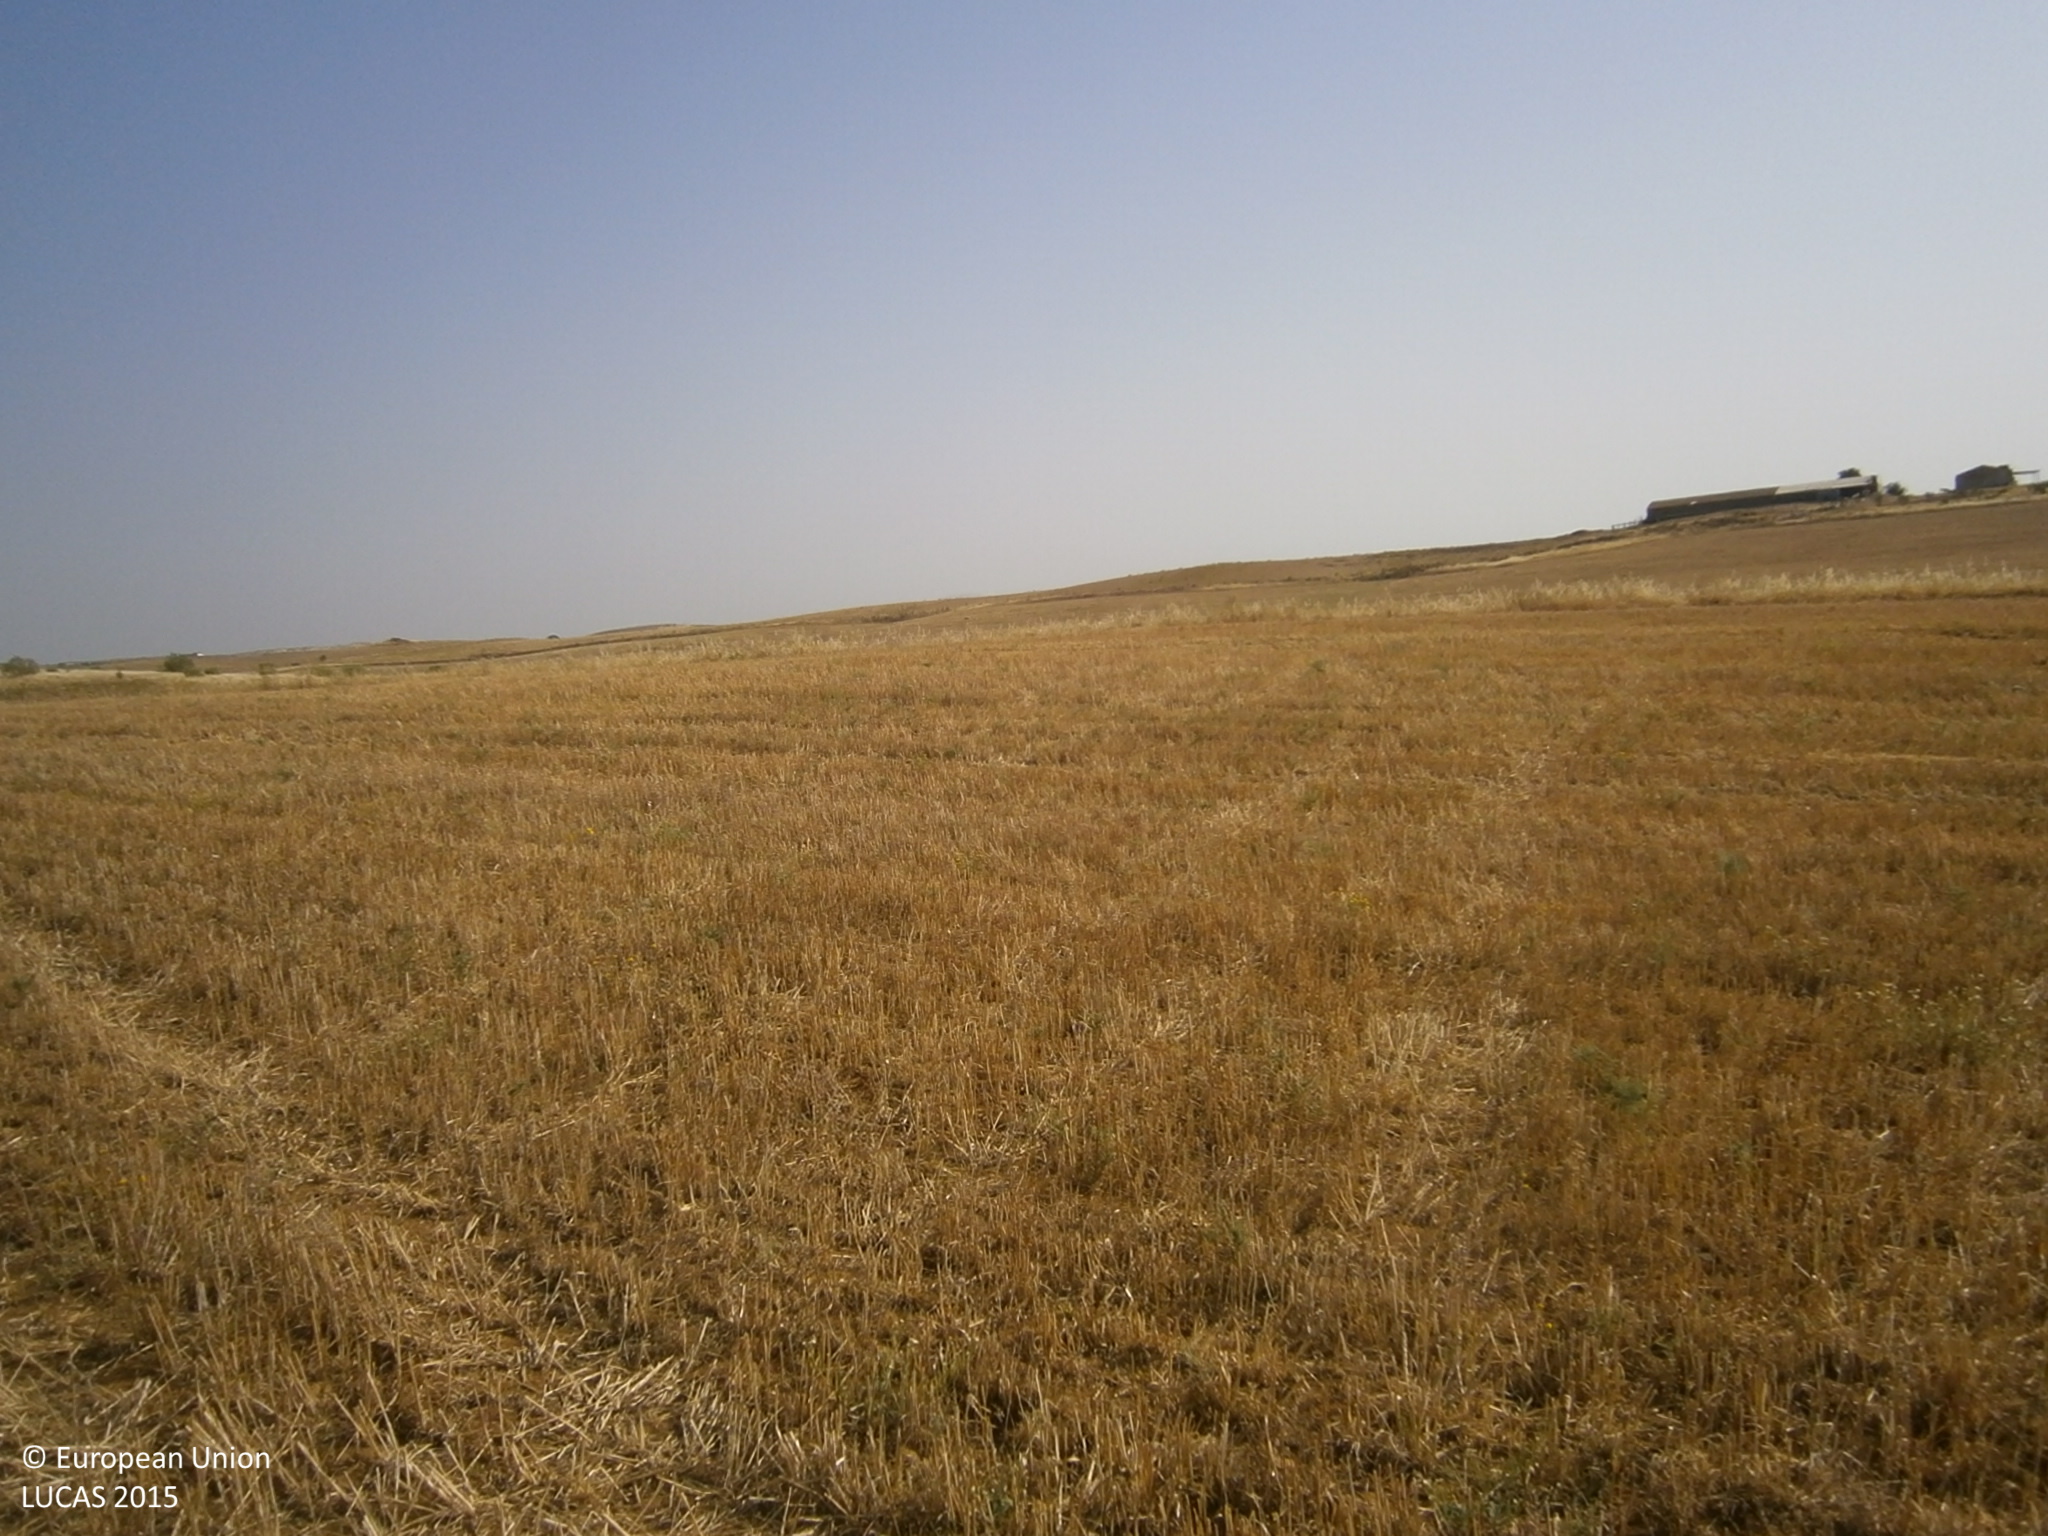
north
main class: Cropland
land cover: Temporary grasslands
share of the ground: > 75 %
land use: Agriculture (excluding fallow land and kitchen gardens)
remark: Harvested field
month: June
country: ES
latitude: 38.8483
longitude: -6.2431
